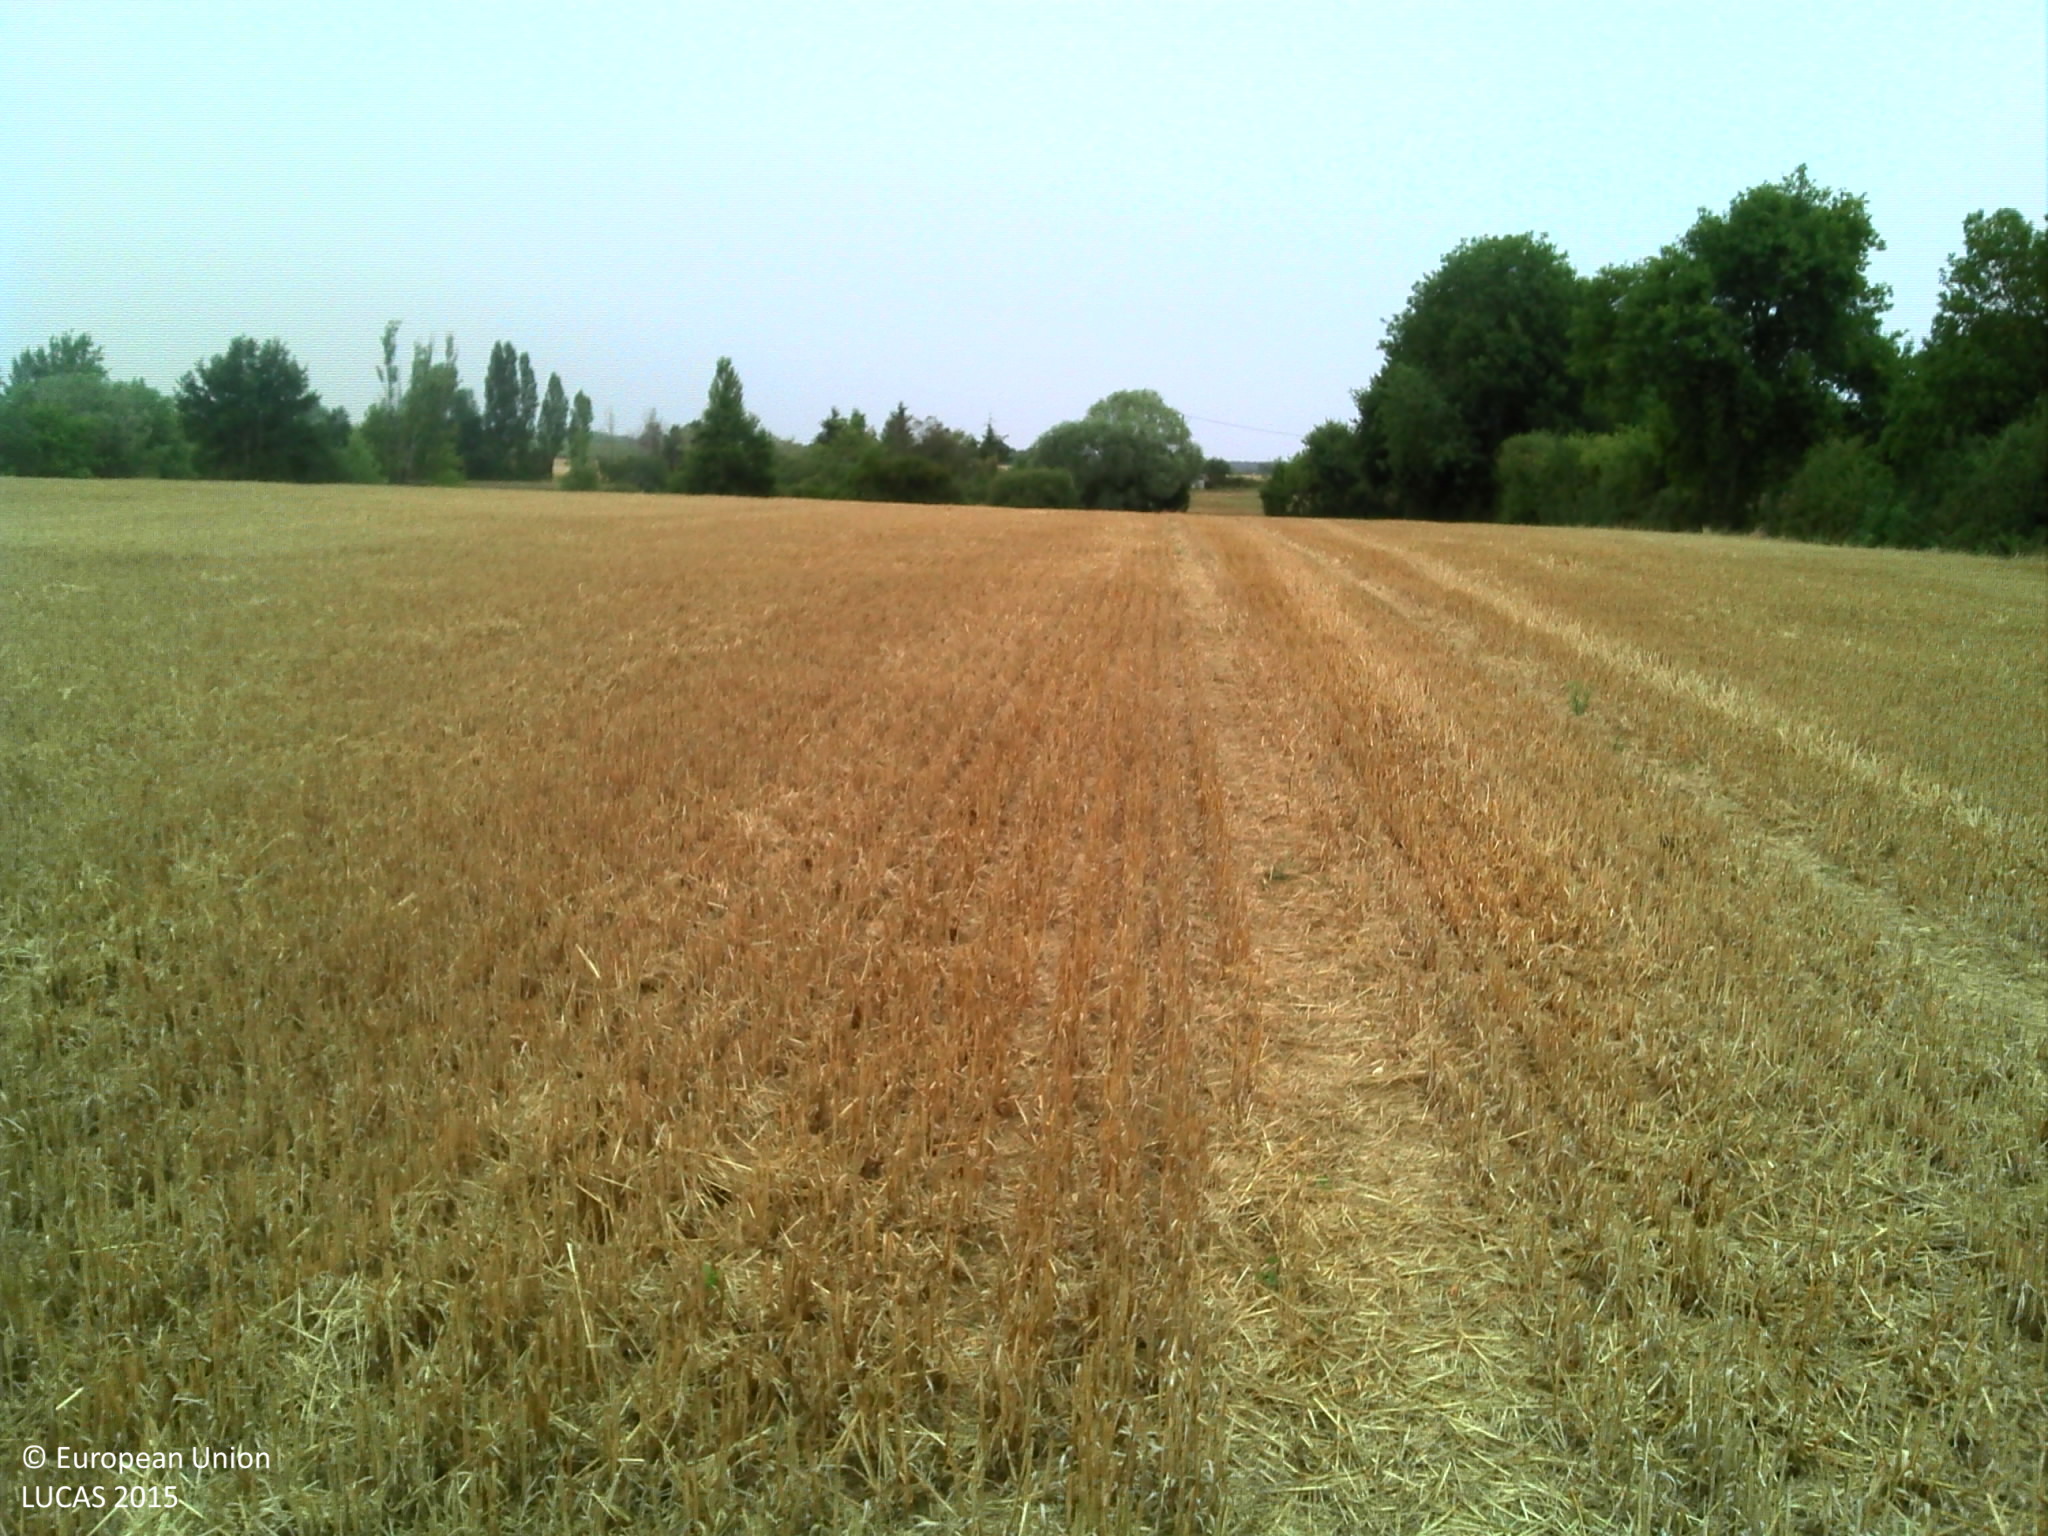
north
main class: Cropland
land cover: Common wheat
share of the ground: > 75 %
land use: Agriculture (excluding fallow land and kitchen gardens)
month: July
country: FR
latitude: 46.8056
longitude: 2.1695
